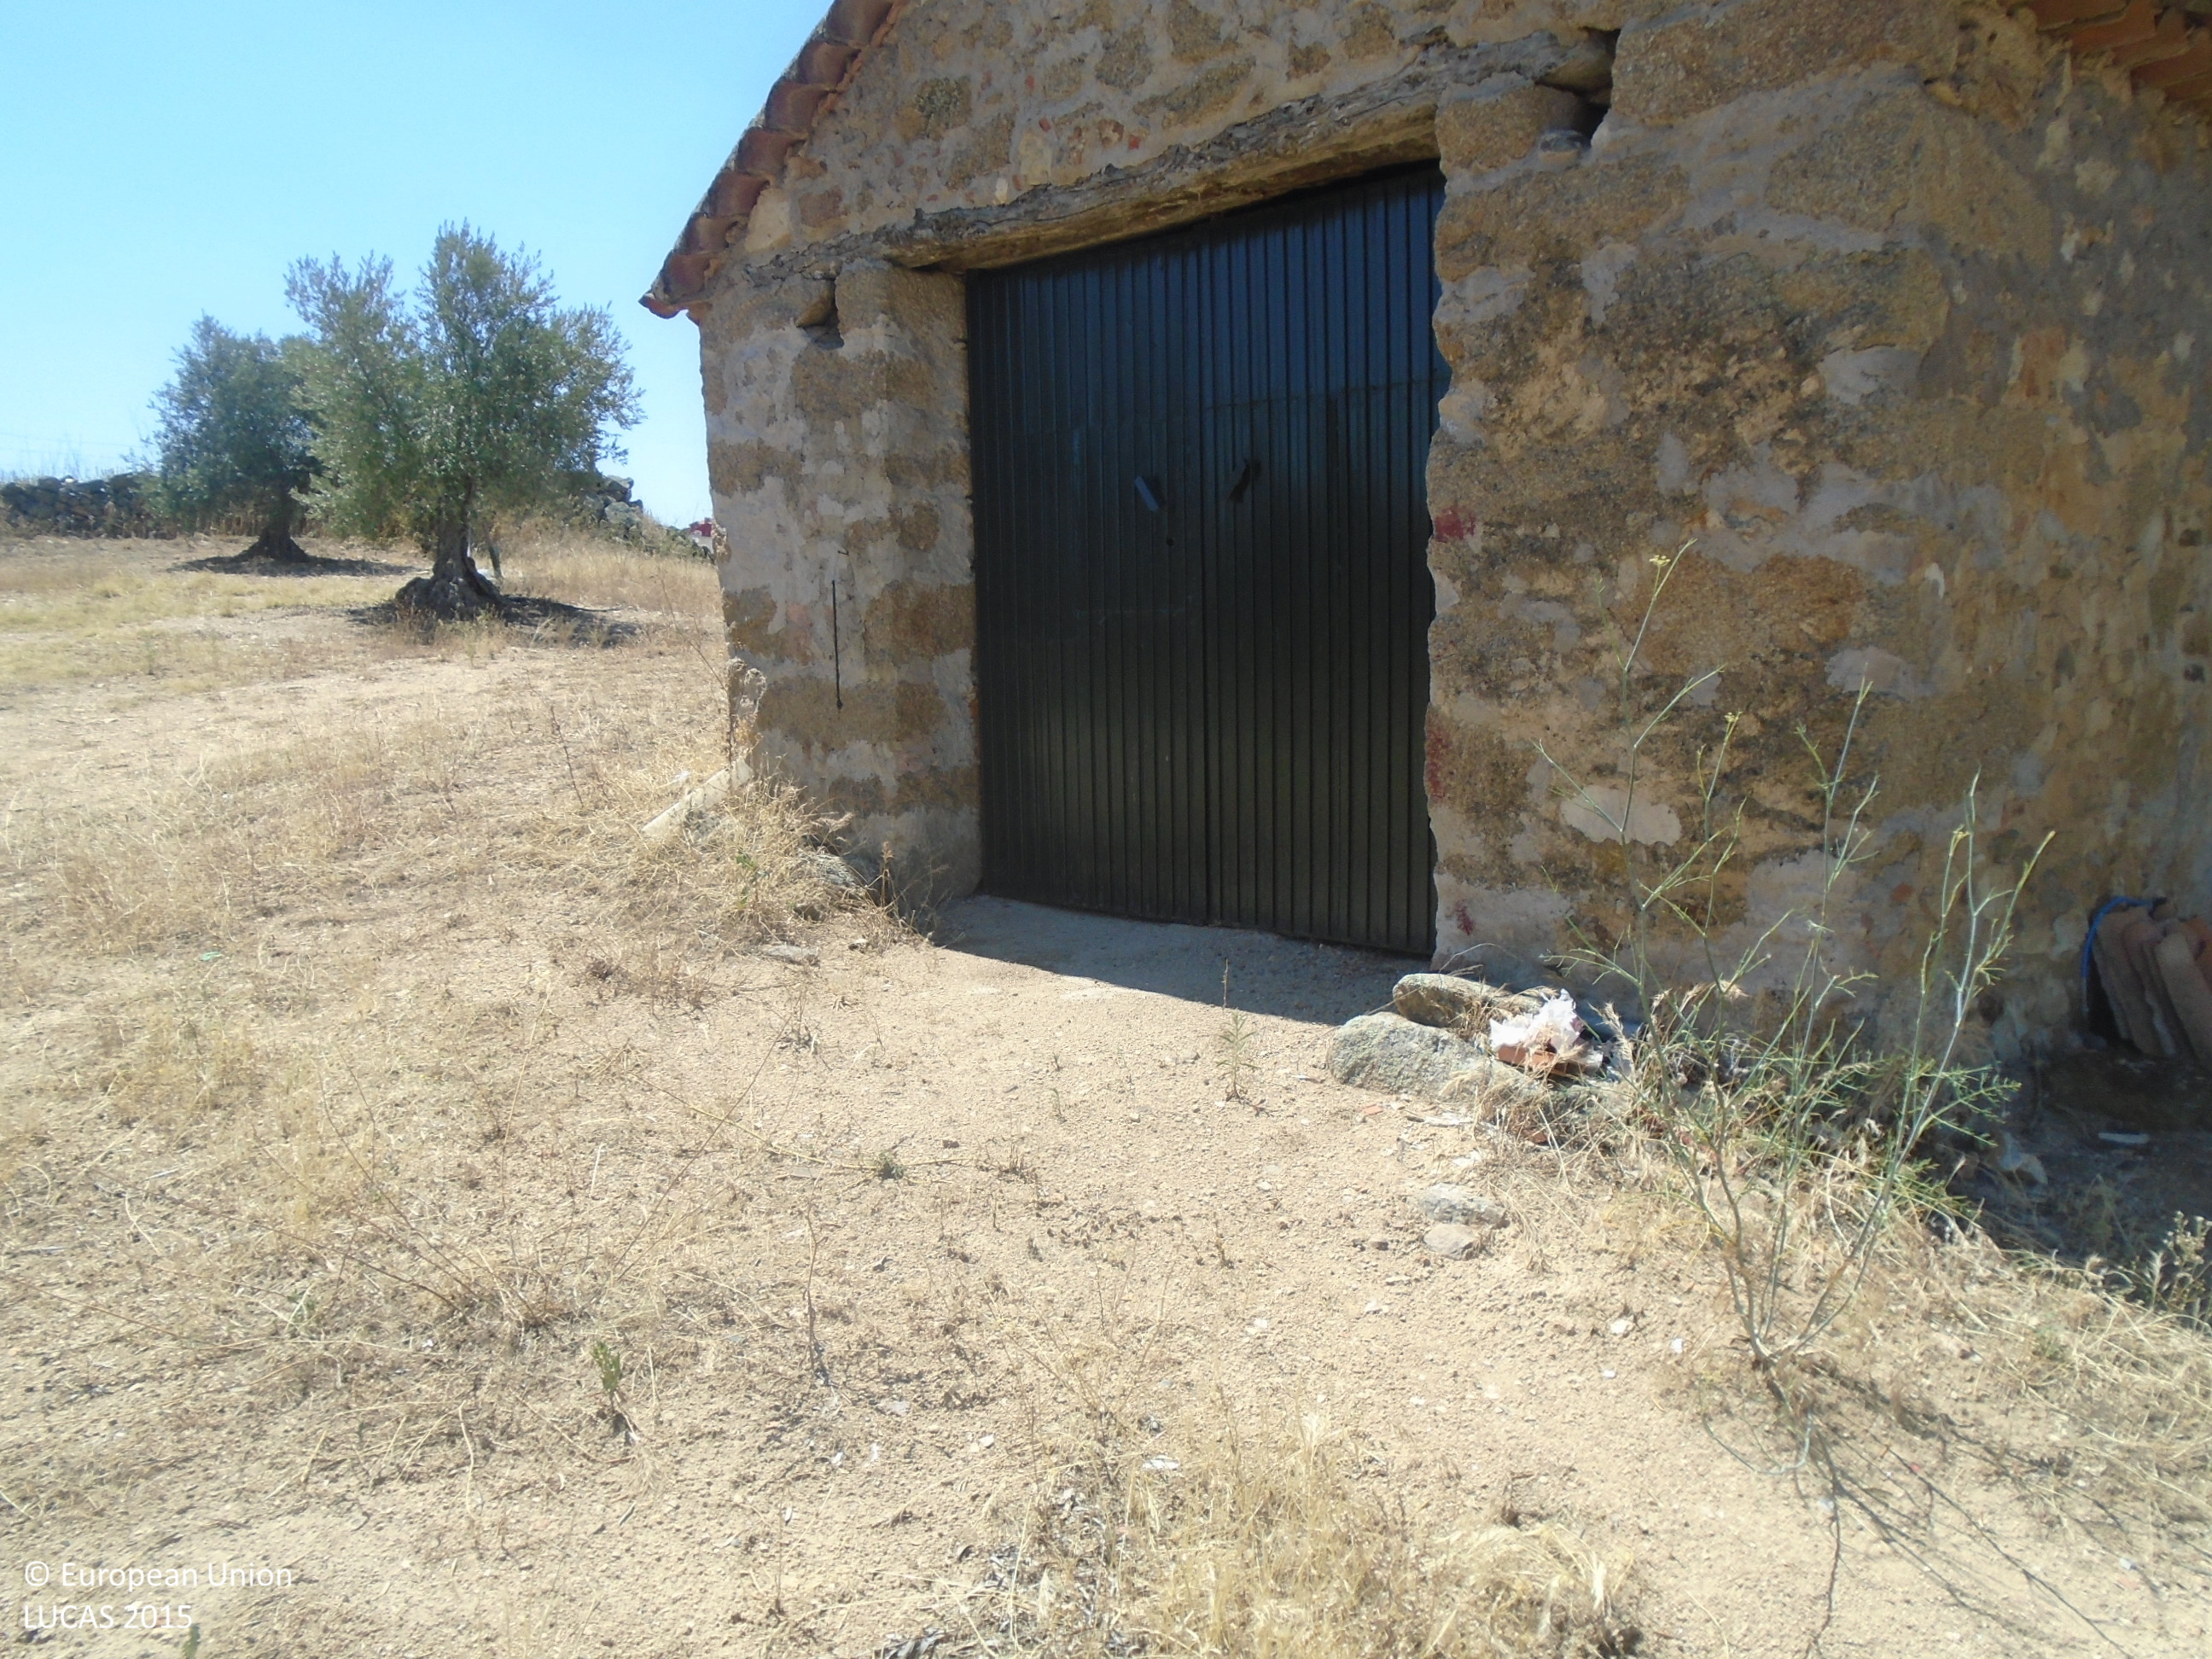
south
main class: Cropland
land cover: Olive groves
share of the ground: 10 - 25 %
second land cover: Spontaneously vegetated surfaces
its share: > 75 %
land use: Agriculture (excluding fallow land and kitchen gardens)
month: July
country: ES
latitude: 39.7642
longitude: -5.0247
